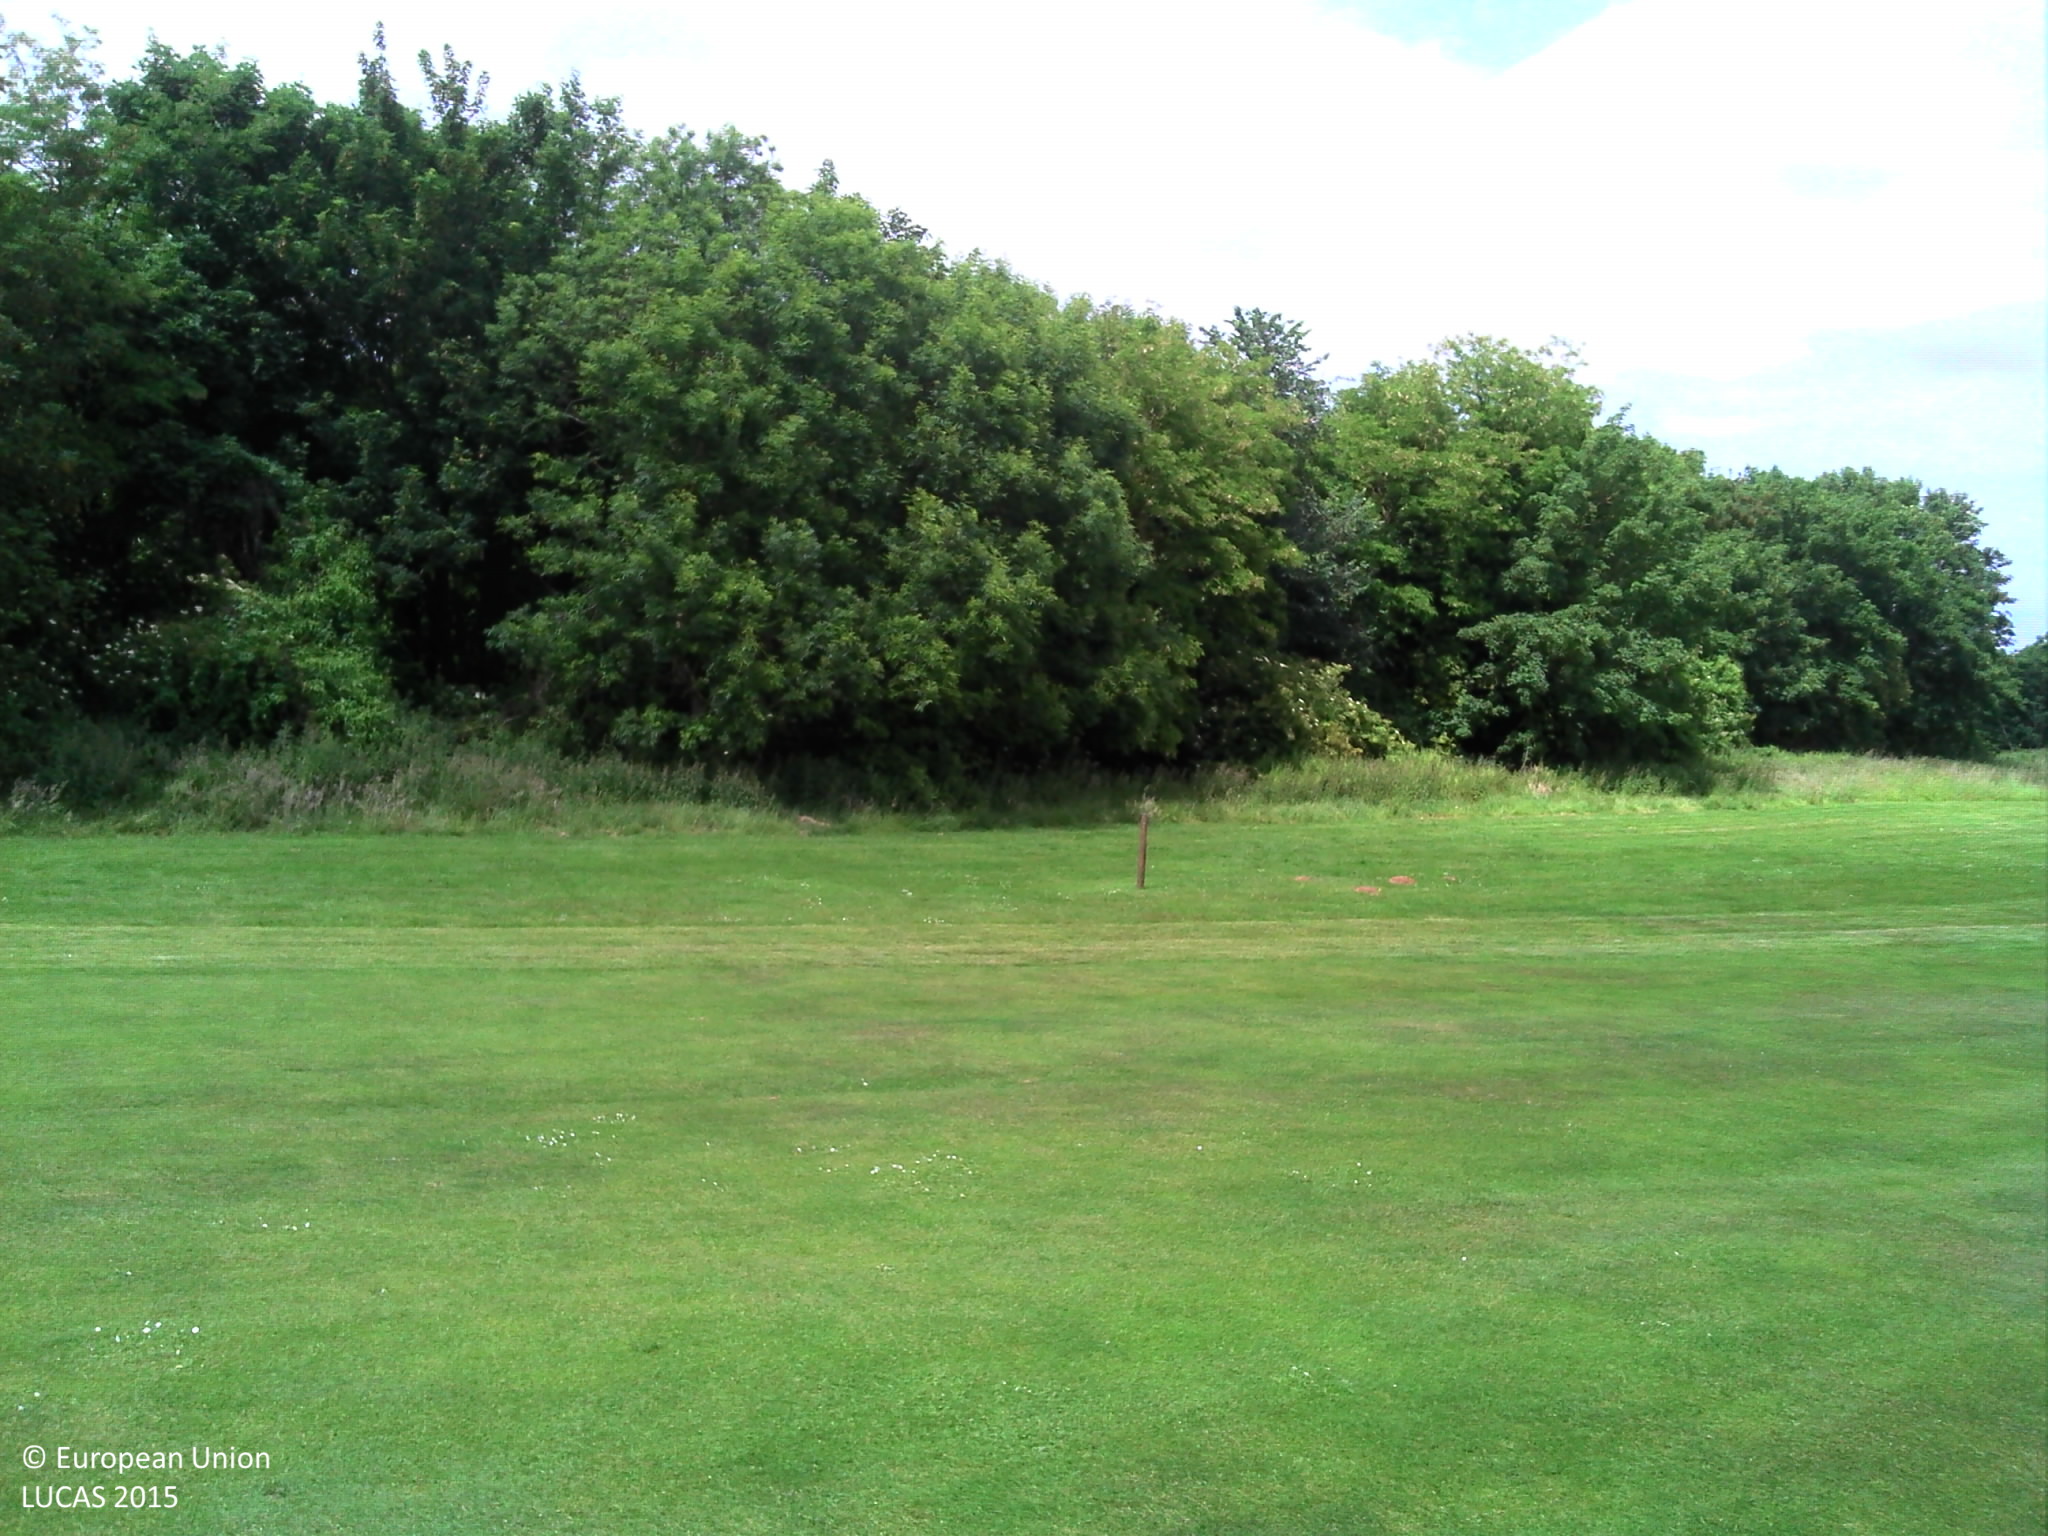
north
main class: Grassland
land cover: Grassland without tree/shrub cover
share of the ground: > 75 %
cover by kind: herbaceous plants 100 %
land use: Sport
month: June
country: FR
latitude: 49.2227
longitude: -0.3462
